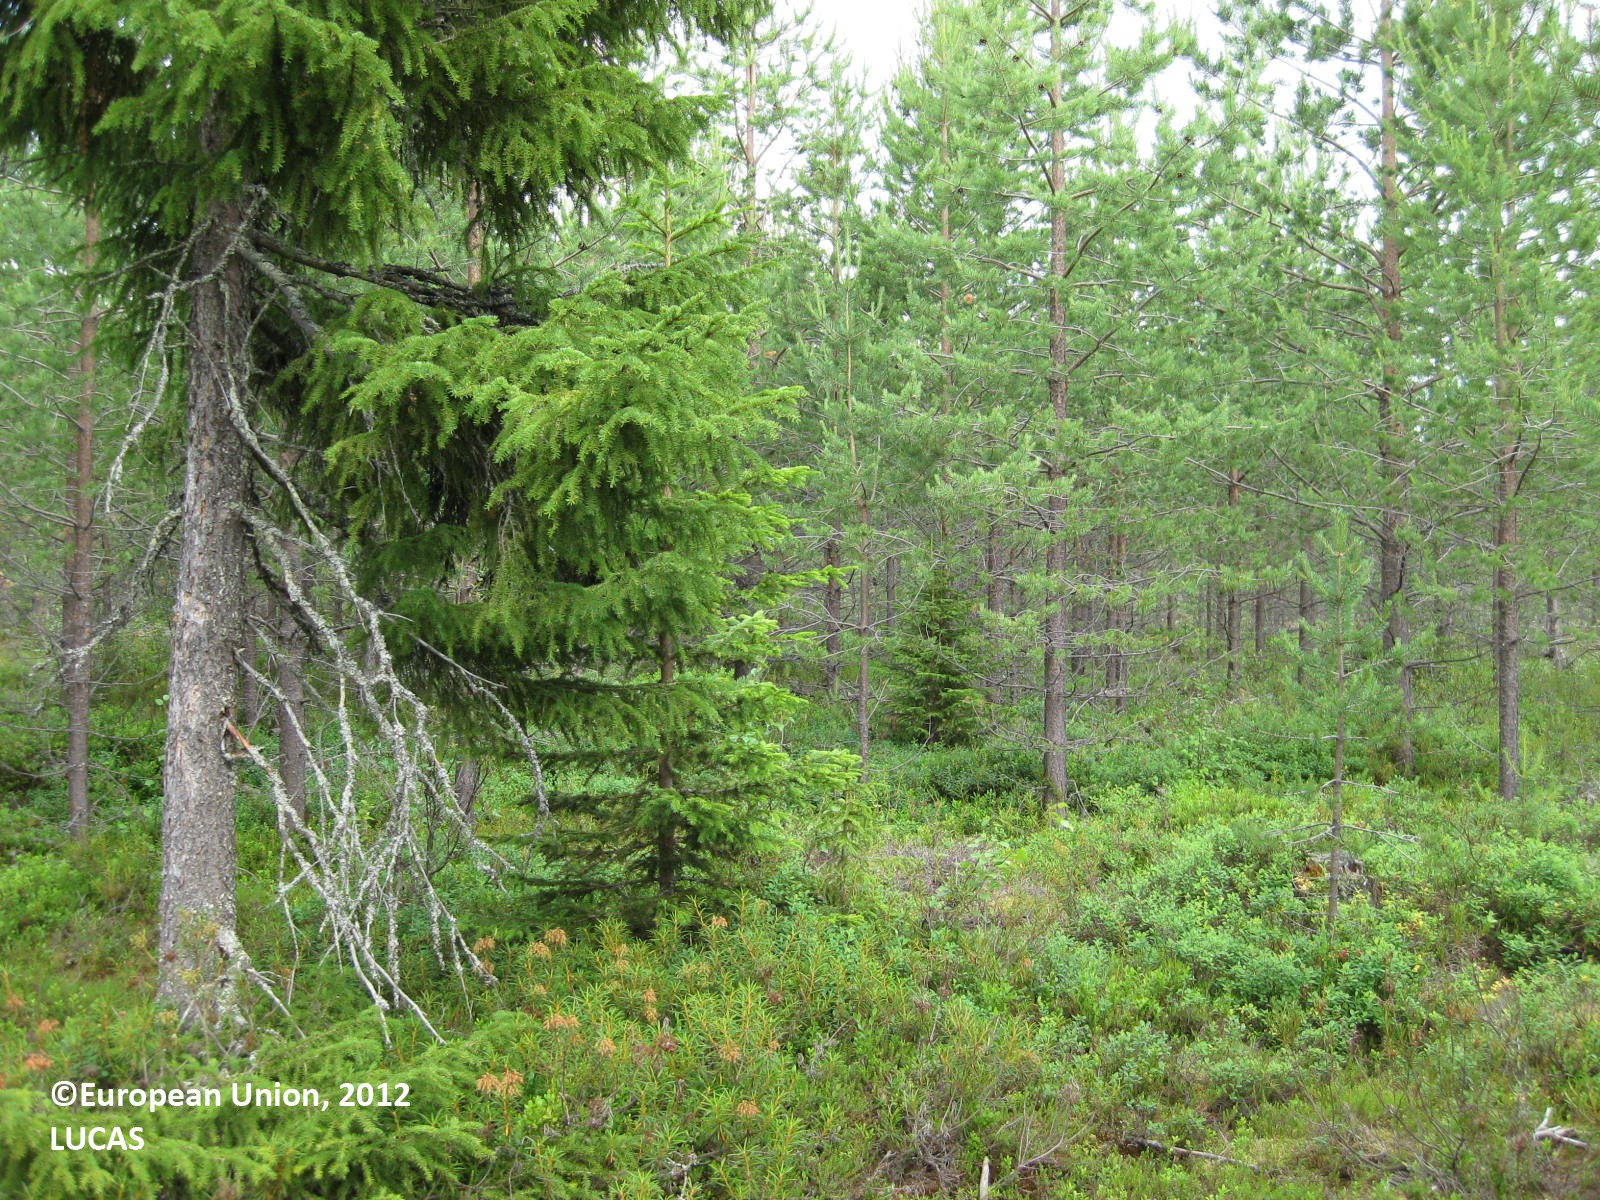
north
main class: Woodland
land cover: Pine dominated coniferous woodland
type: boreal forest
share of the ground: > 75 %
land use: Forestry
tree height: > 5 m
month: July
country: FI
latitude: 65.6555
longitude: 29.2529
